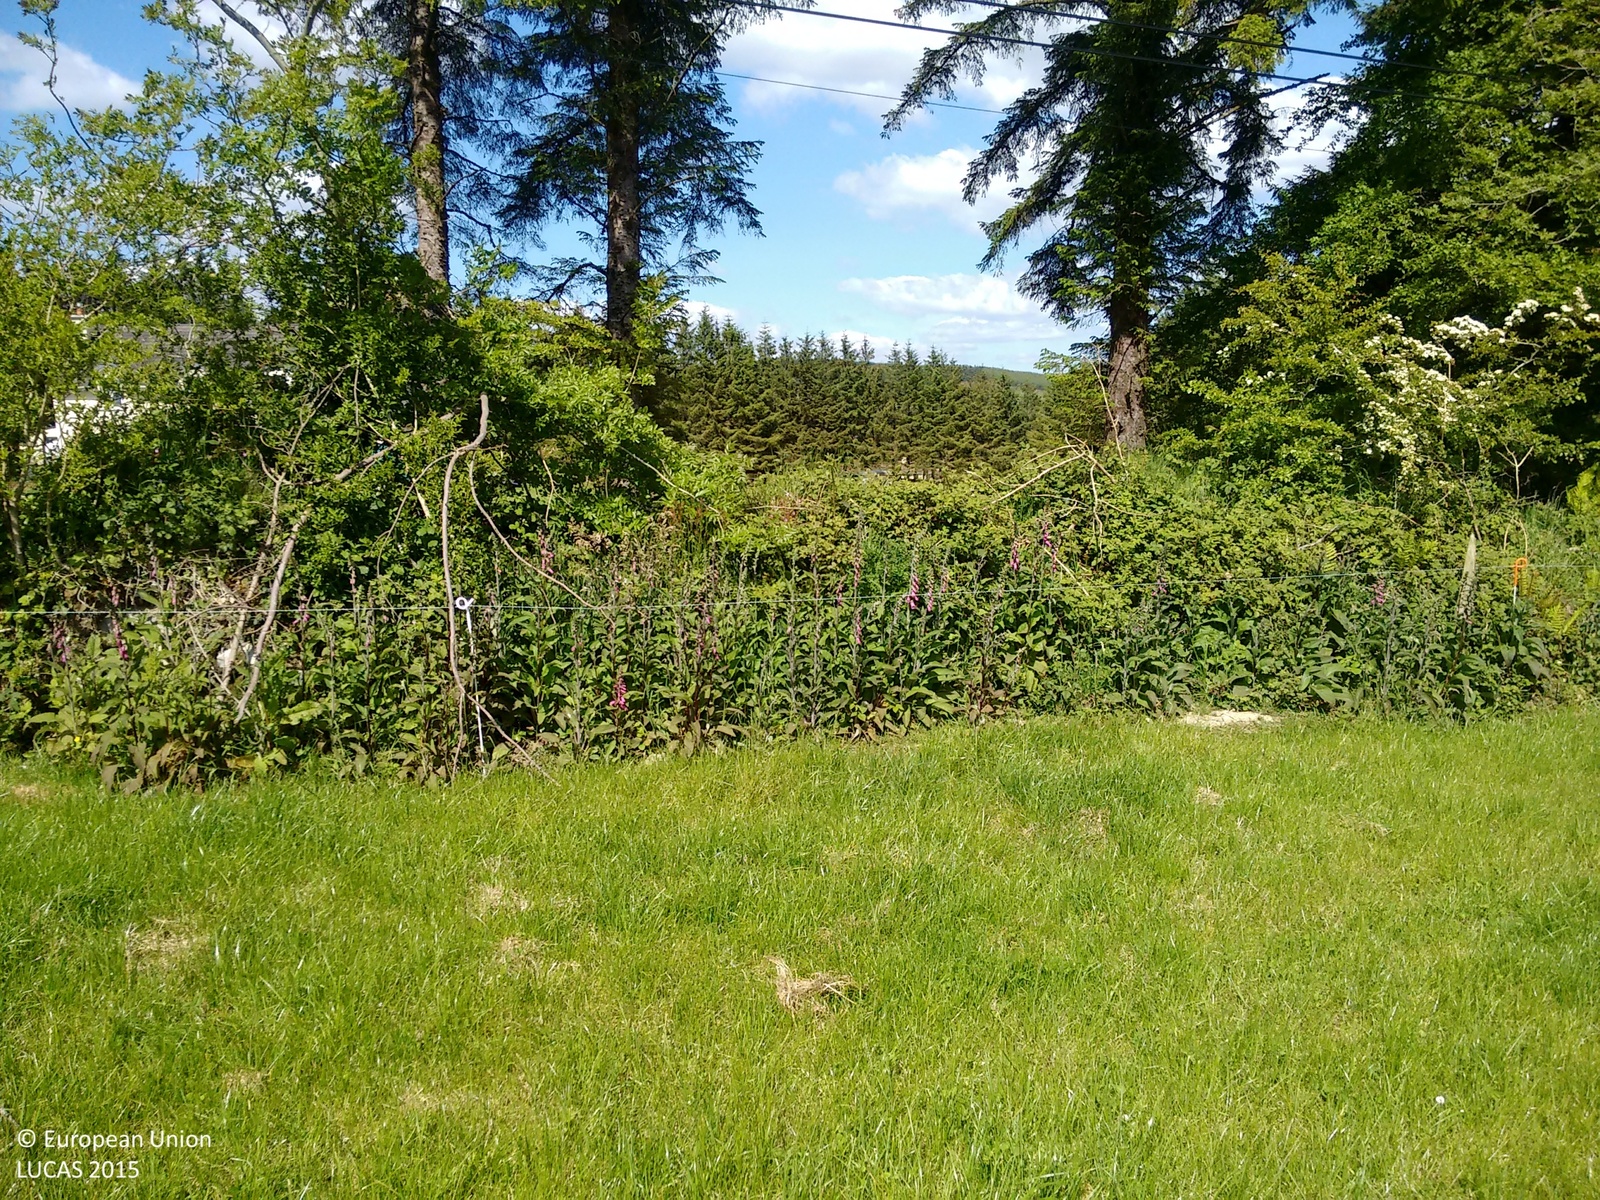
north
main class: Grassland
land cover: Grassland without tree/shrub cover
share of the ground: > 75 %
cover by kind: herbaceous plants 95 %, shrubs 5 %
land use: Agriculture (excluding fallow land and kitchen gardens)
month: June
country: IE
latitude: 51.9911
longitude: -8.8628
